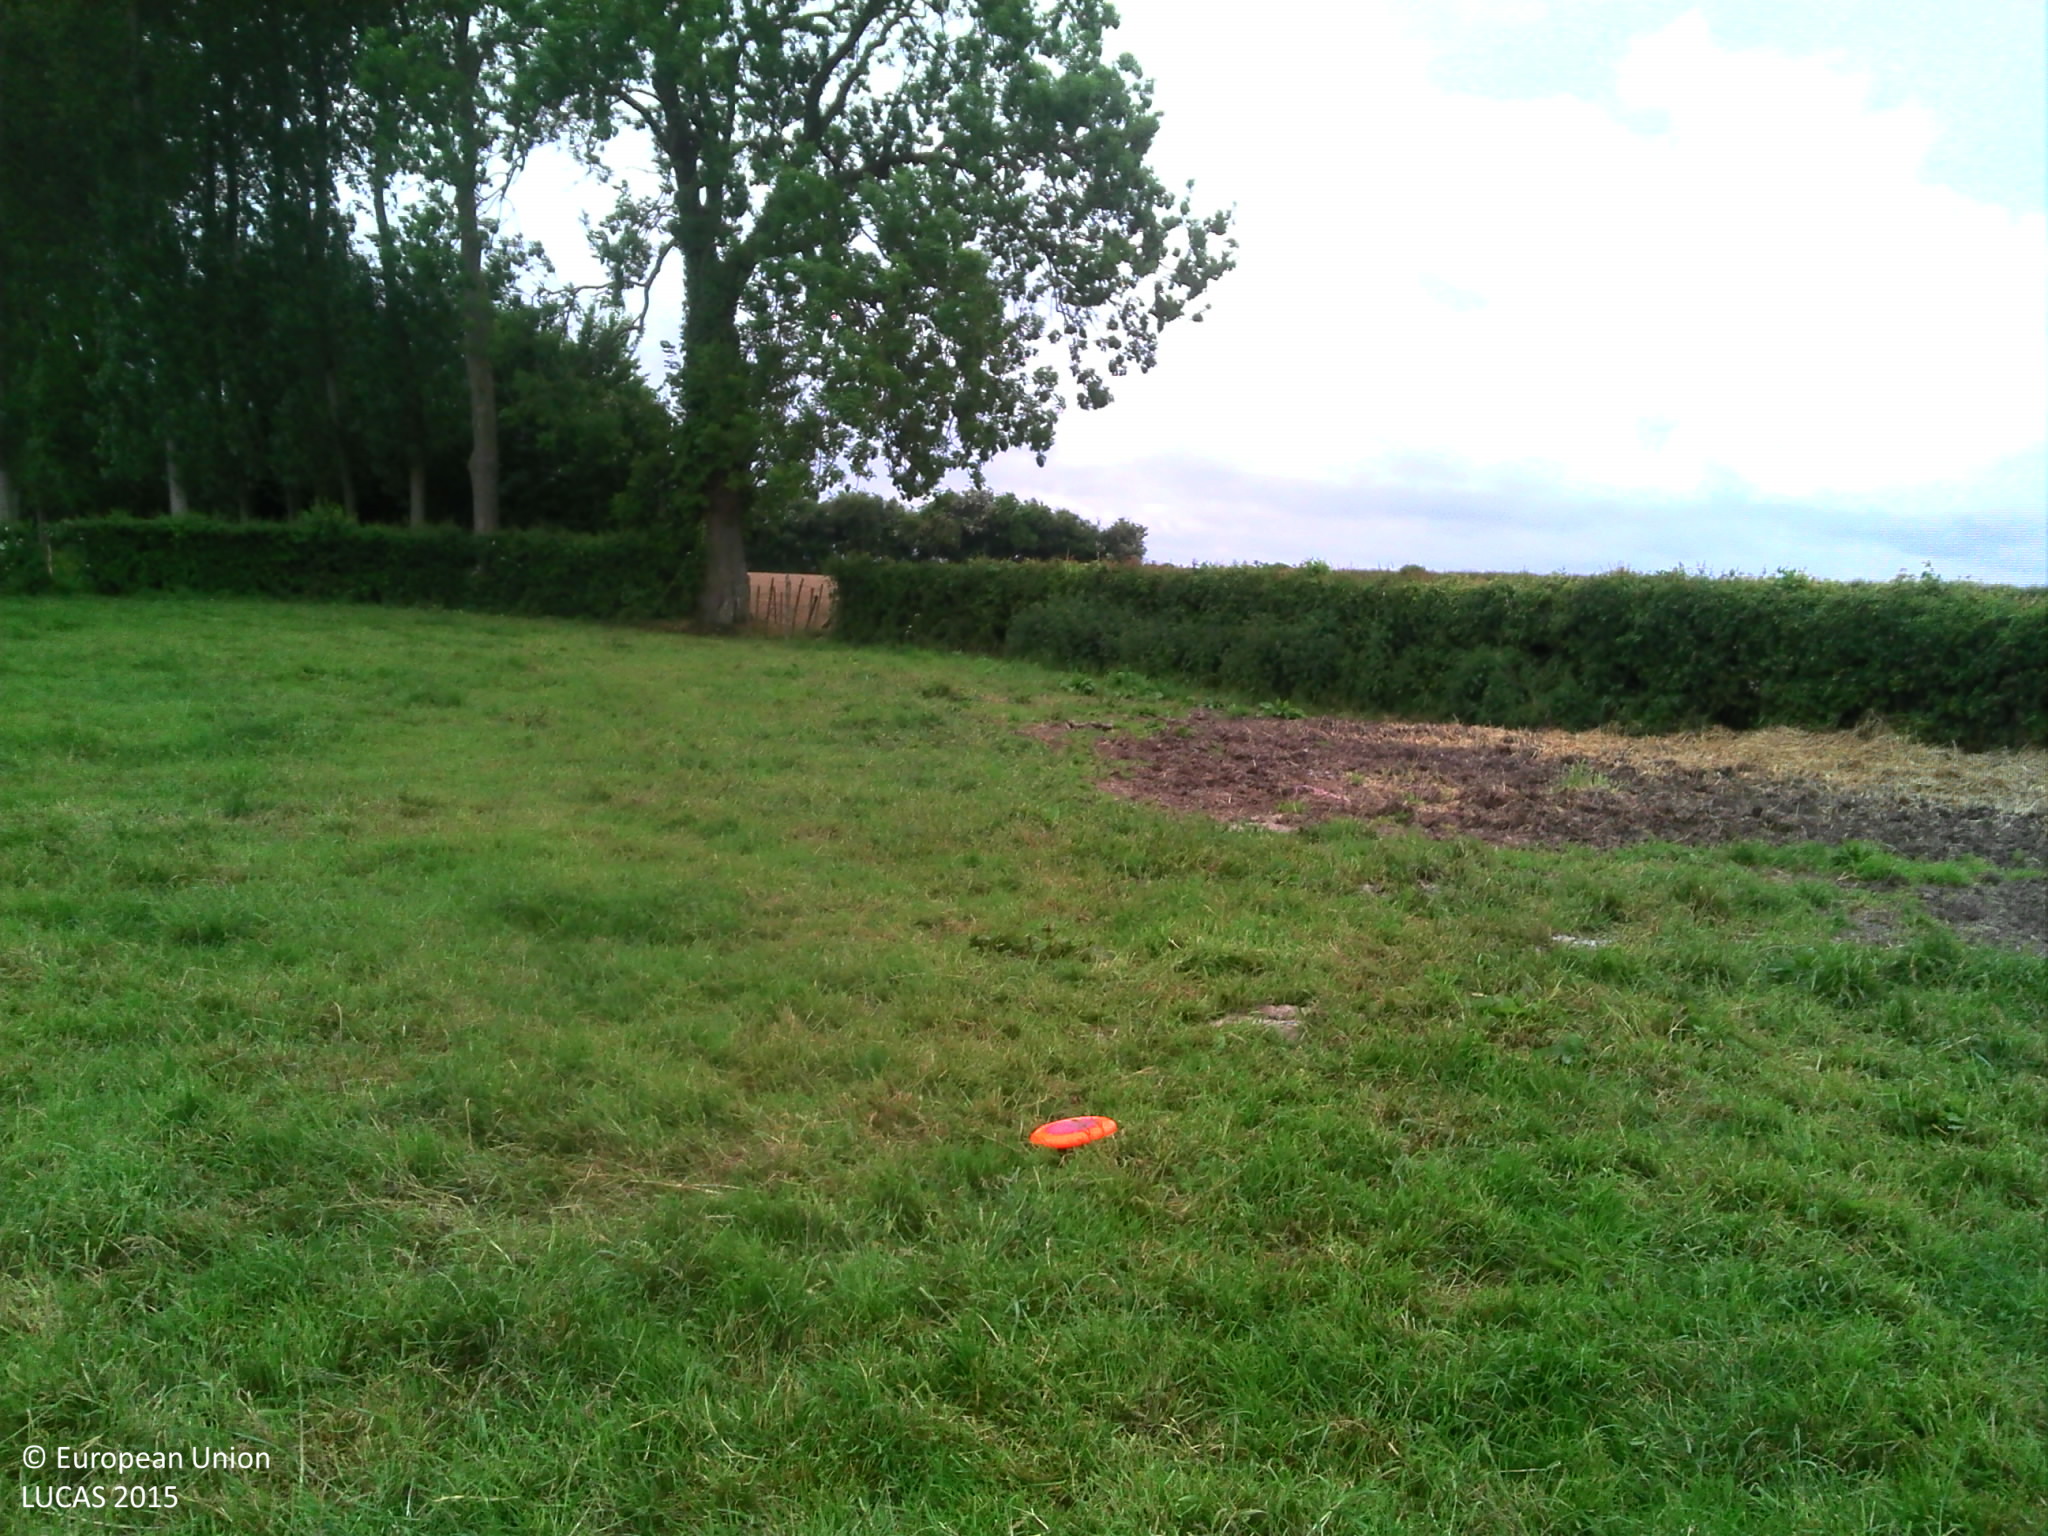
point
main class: Grassland
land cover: Grassland without tree/shrub cover
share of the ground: > 75 %
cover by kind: herbaceous plants 100 %
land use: Agriculture (excluding fallow land and kitchen gardens)
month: May
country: FR
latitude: 50.0599
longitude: 1.6710
